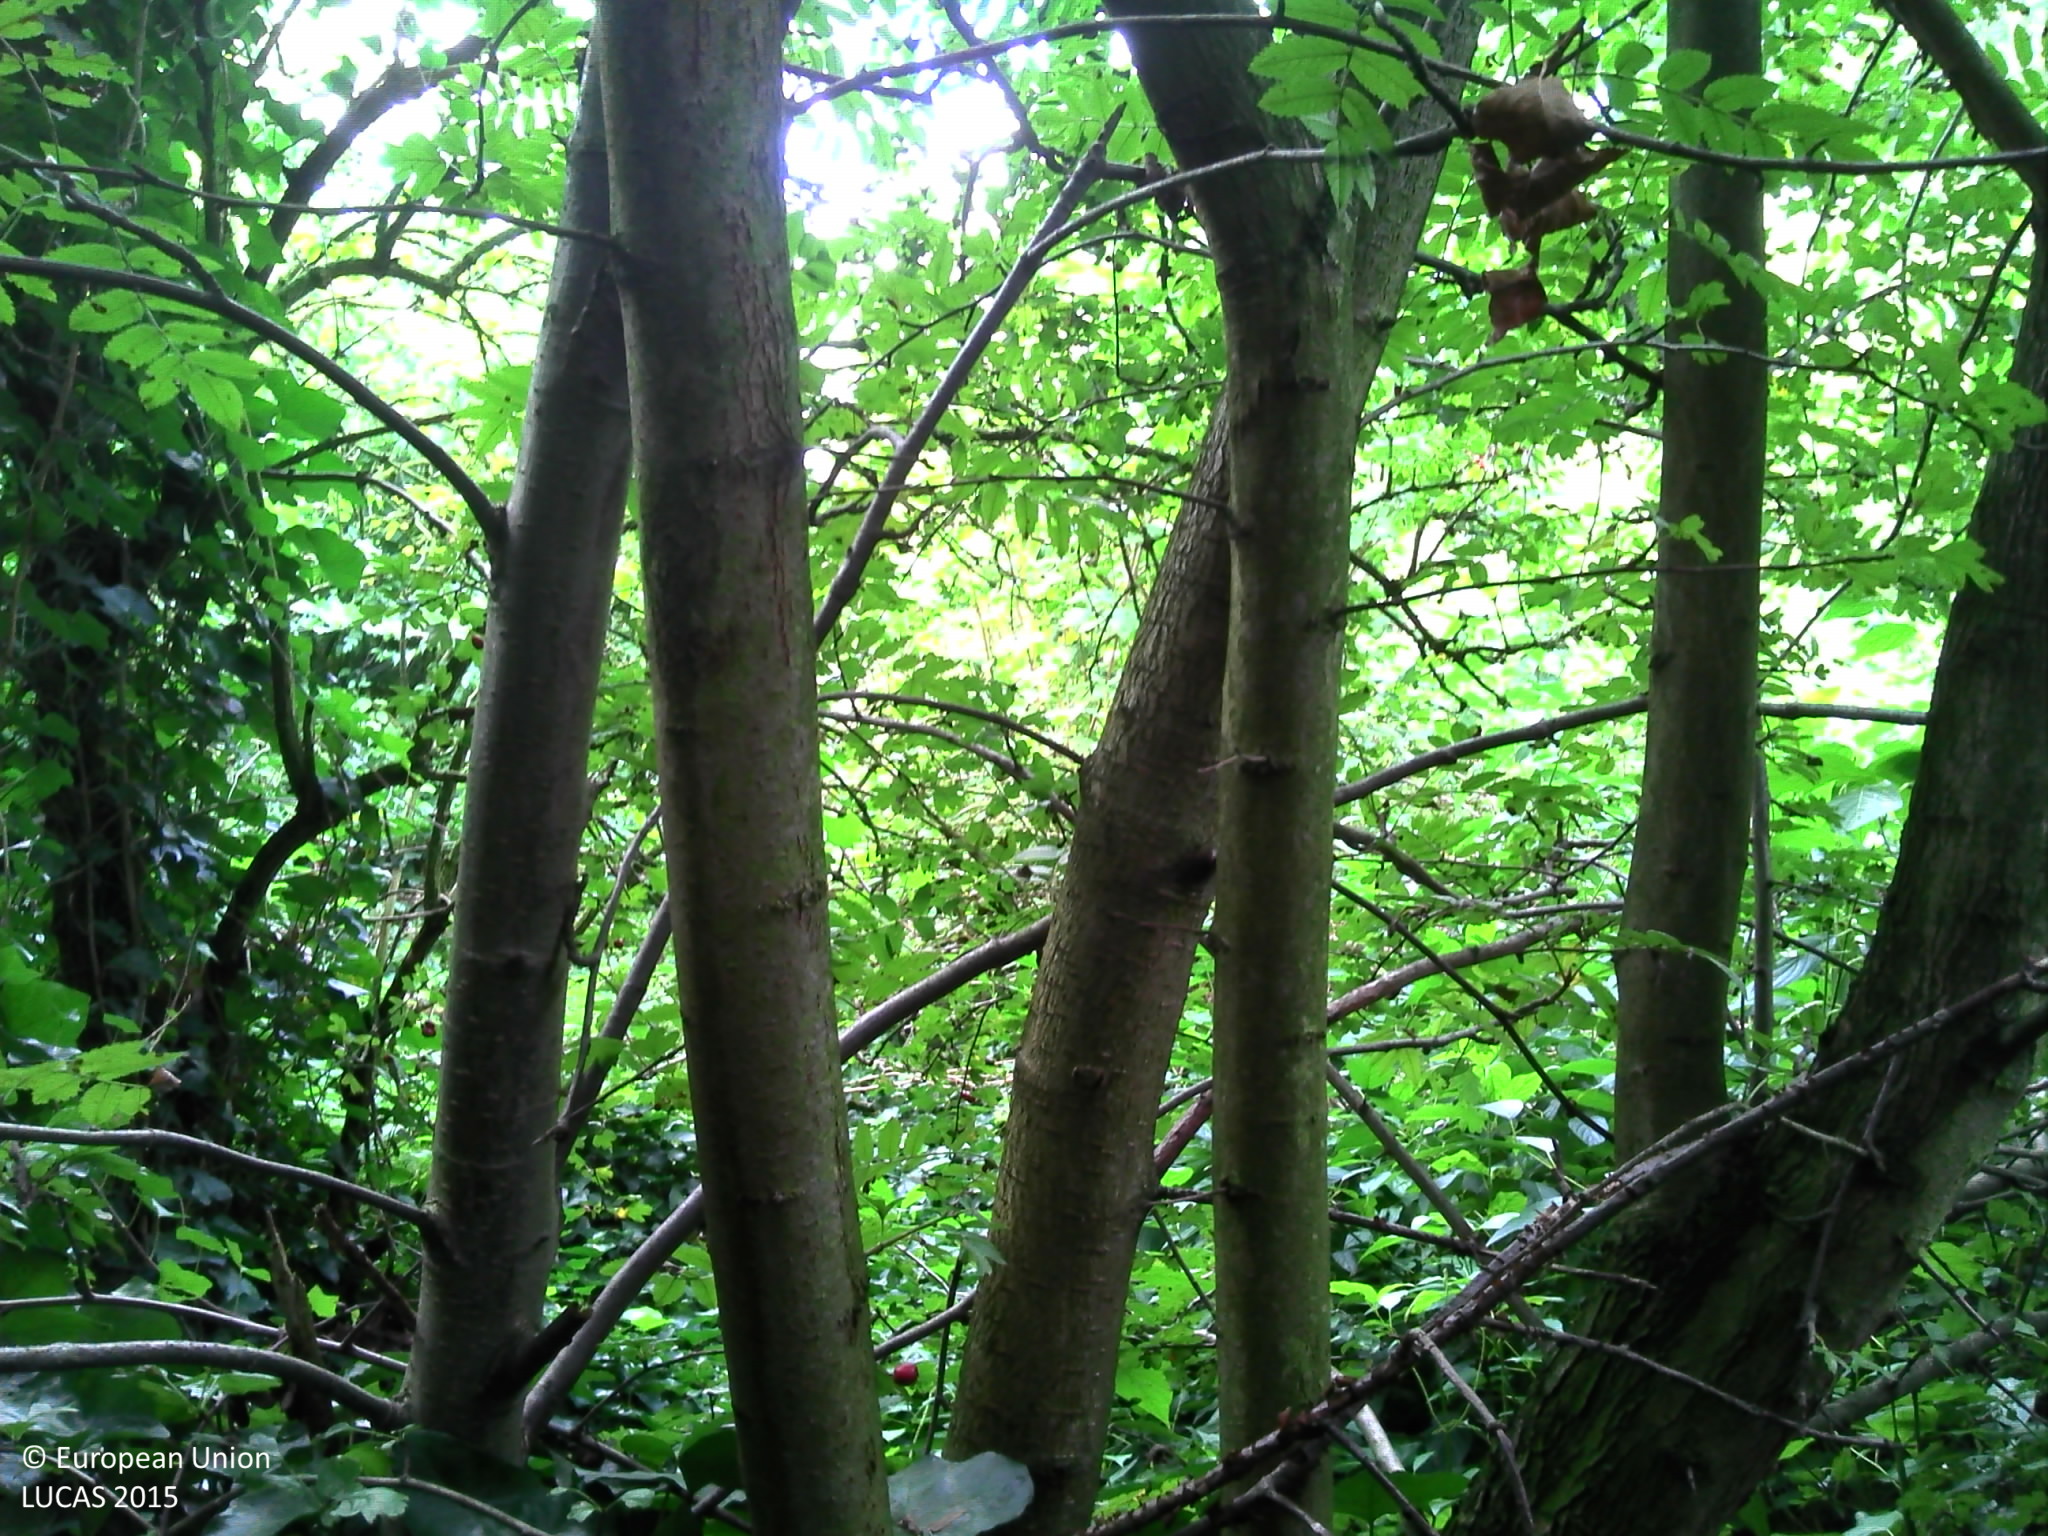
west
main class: Woodland
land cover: Broadleaved woodland
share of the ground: > 75 %
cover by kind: broadleaved forest trees 65 %, shrubs 15 %, coniferous forest trees 10 %, herbaceous plants 10 %
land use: Semi-natural and natural areas not in use
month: September
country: BE
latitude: 51.1616
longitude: 4.3470
